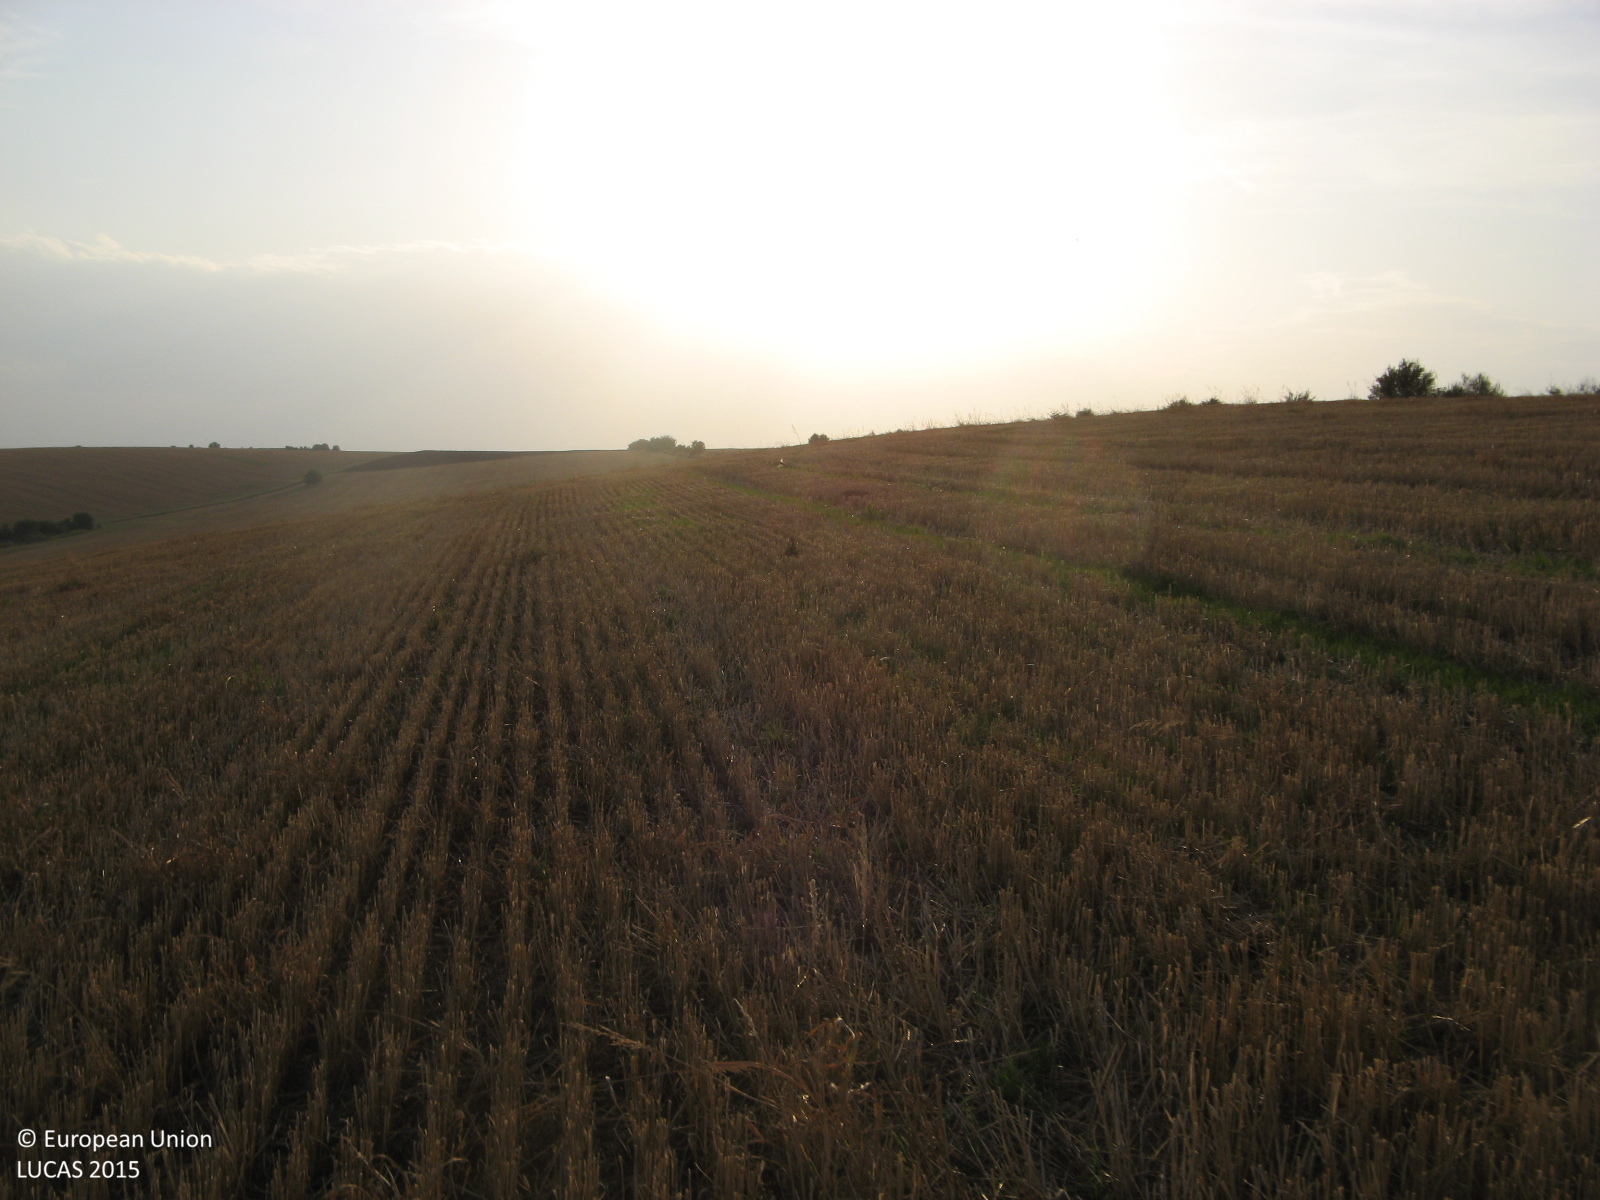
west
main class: Cropland
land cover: Common wheat
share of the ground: 50 - 75 %
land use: Agriculture (excluding fallow land and kitchen gardens)
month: September
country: BG
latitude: 43.5345
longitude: 25.5638
